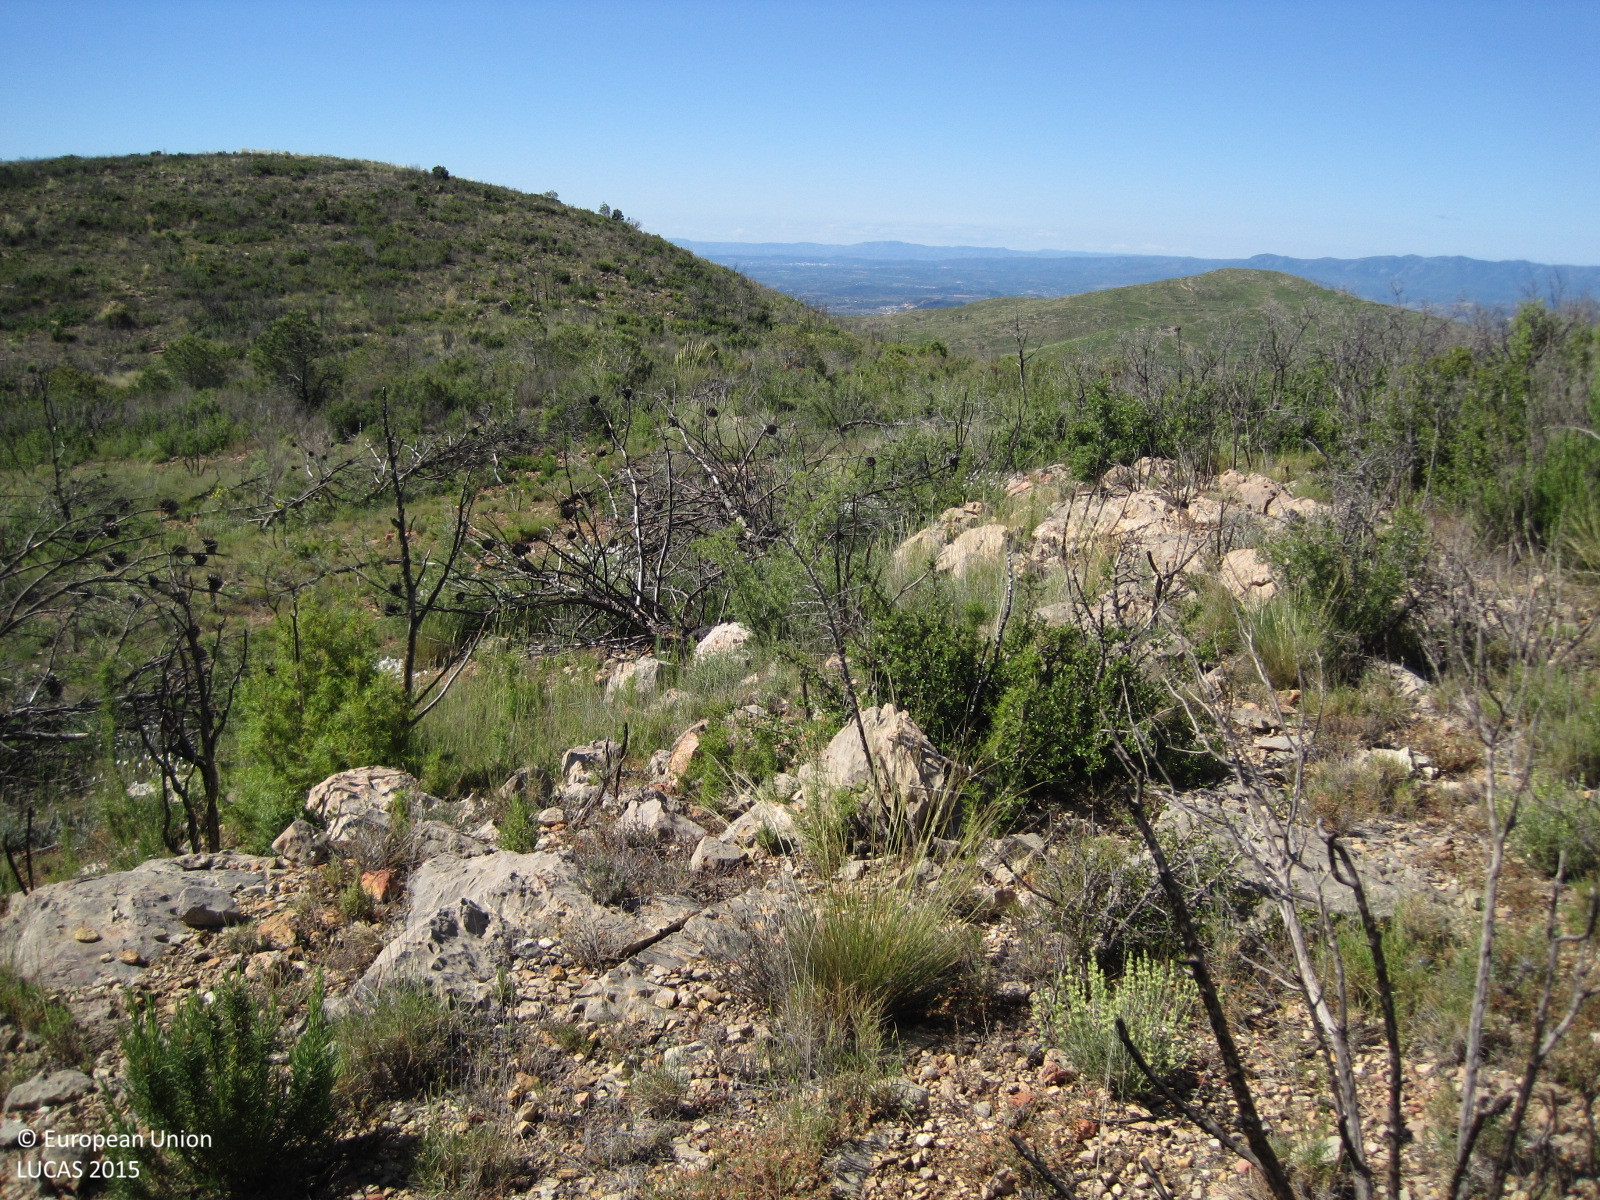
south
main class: Shrubland
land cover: Shrubland with sparse tree cover
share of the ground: 50 - 75 %
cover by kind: shrubs 60 %, consolidated bare surface 25 %, herbaceous plants 10 %, coniferous forest trees 5 %
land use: Semi-natural and natural areas not in use
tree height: > 5 m
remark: Burnt area
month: May
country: ES
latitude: 39.7759
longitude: -0.6614
